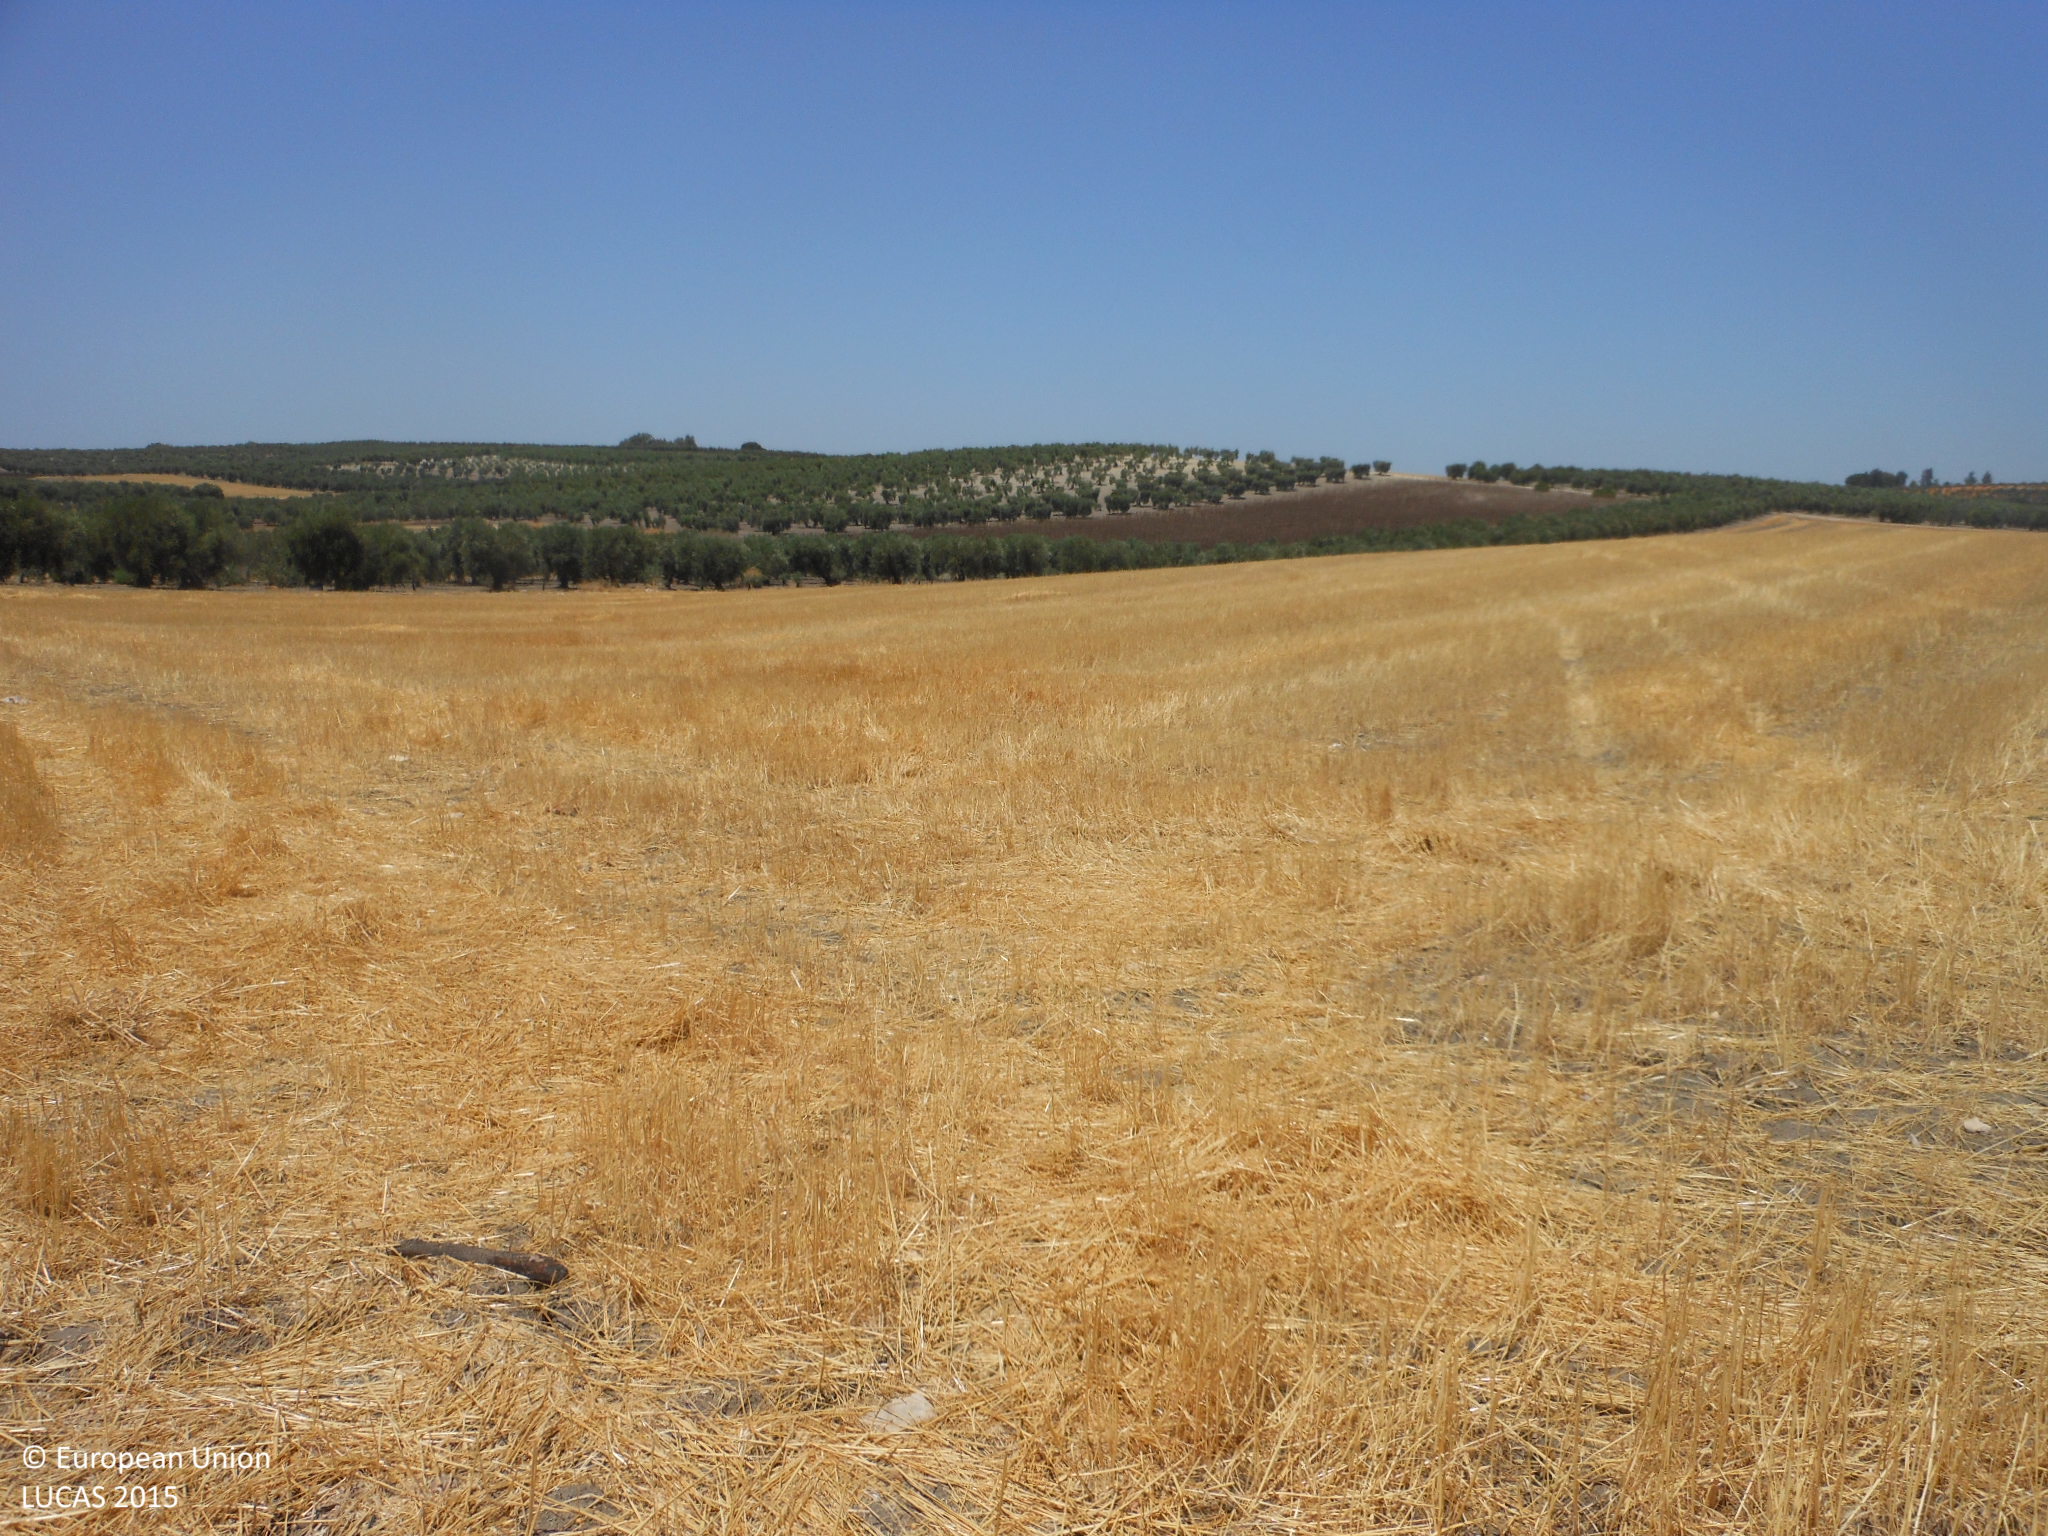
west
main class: Cropland
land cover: Common wheat
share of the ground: < 10 %
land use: Agriculture (excluding fallow land and kitchen gardens)
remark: Harvested field
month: July
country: ES
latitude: 37.2476
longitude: -5.3547
